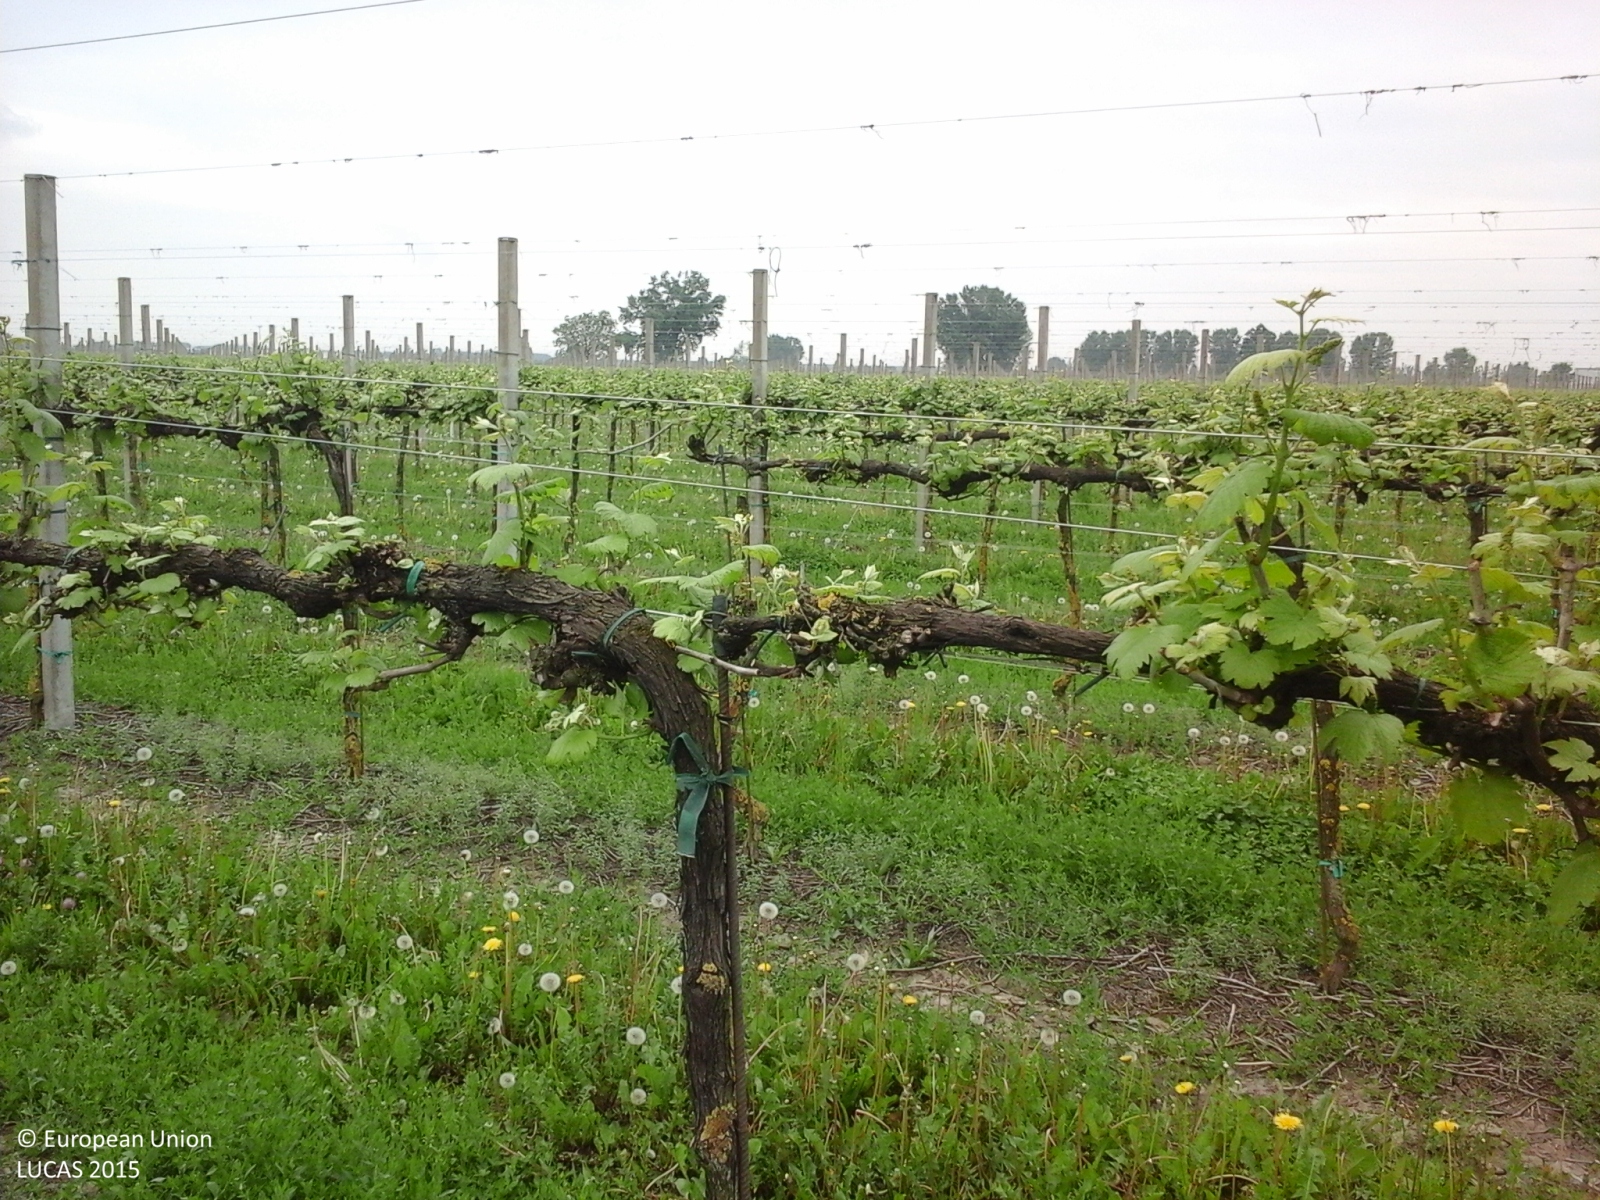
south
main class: Cropland
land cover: Vineyards
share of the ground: 10 - 25 %
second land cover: Grassland without tree/shrub cover
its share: > 75 %
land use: Agriculture (excluding fallow land and kitchen gardens)
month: May
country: IT
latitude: 44.9618
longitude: 10.6200
